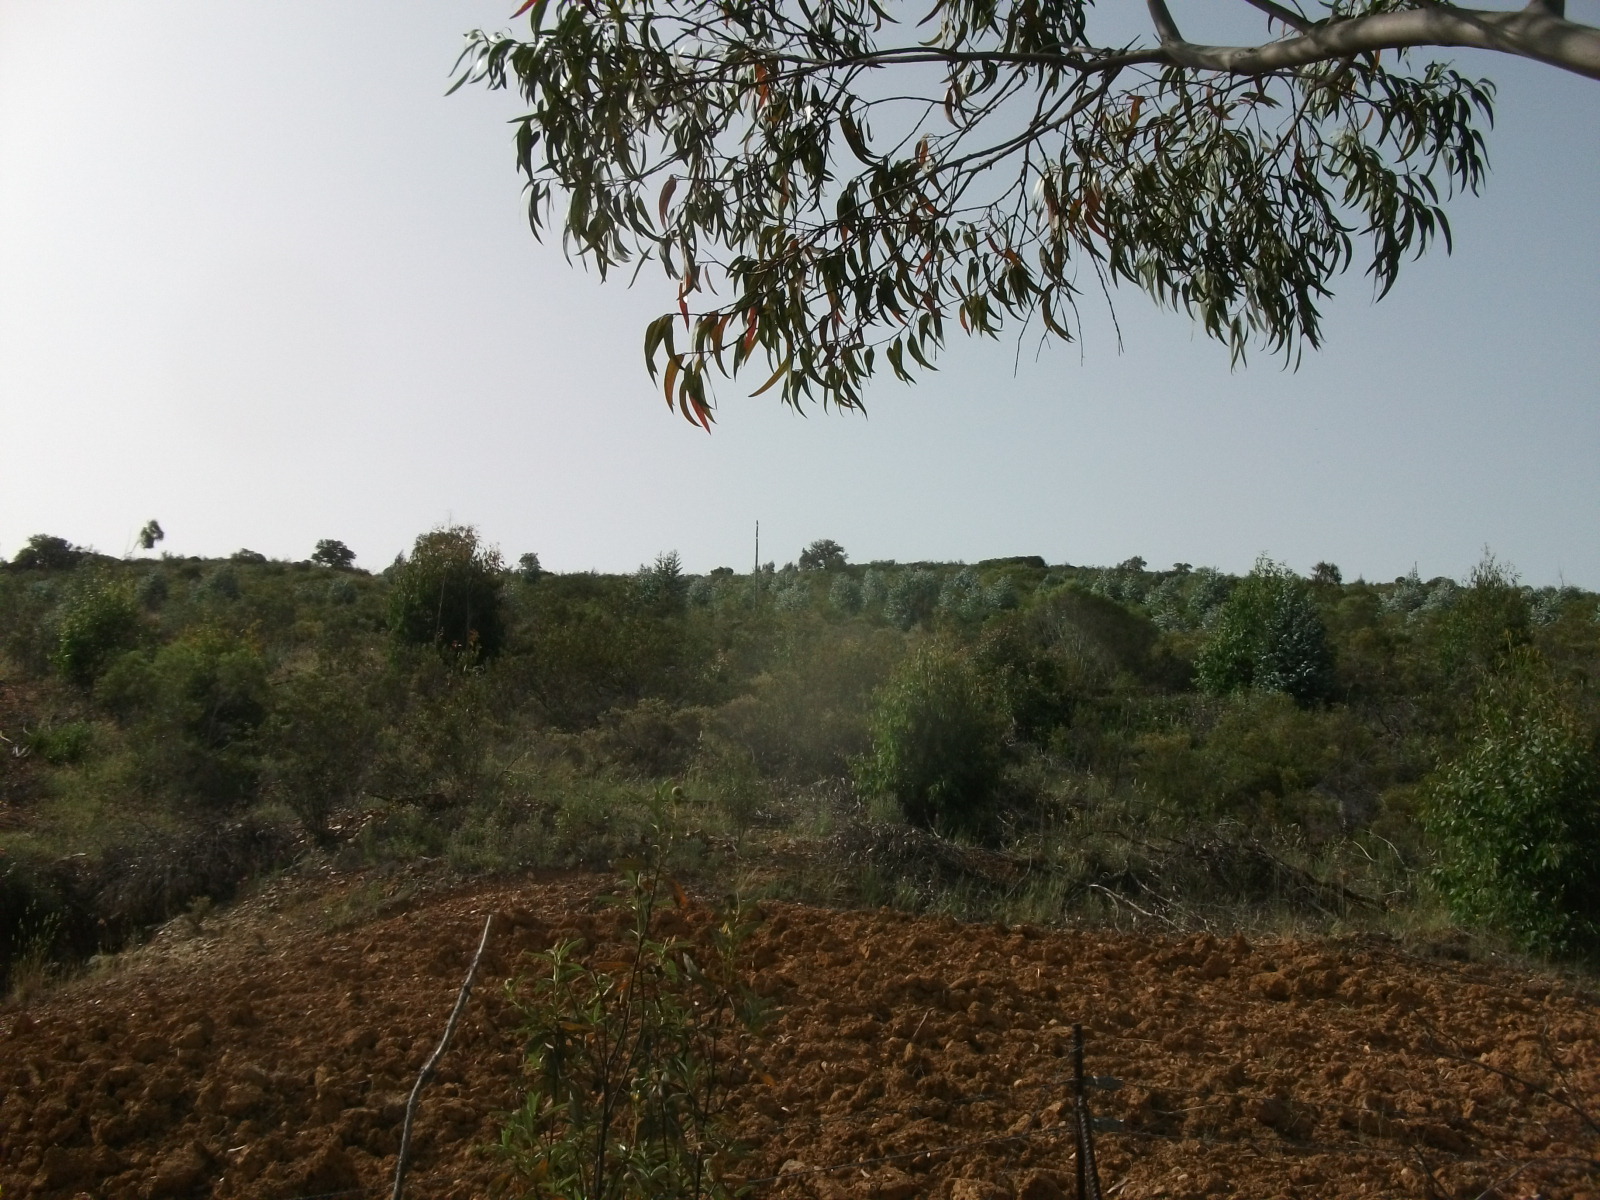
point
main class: Woodland
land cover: Broadleaved woodland
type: exotic forest
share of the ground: 25 - 50 %
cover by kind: shrubs 70 %, broadleaved forest trees 30 %
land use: Forestry
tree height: > 5 m
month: May
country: ES
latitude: 37.7709
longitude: -7.0223
